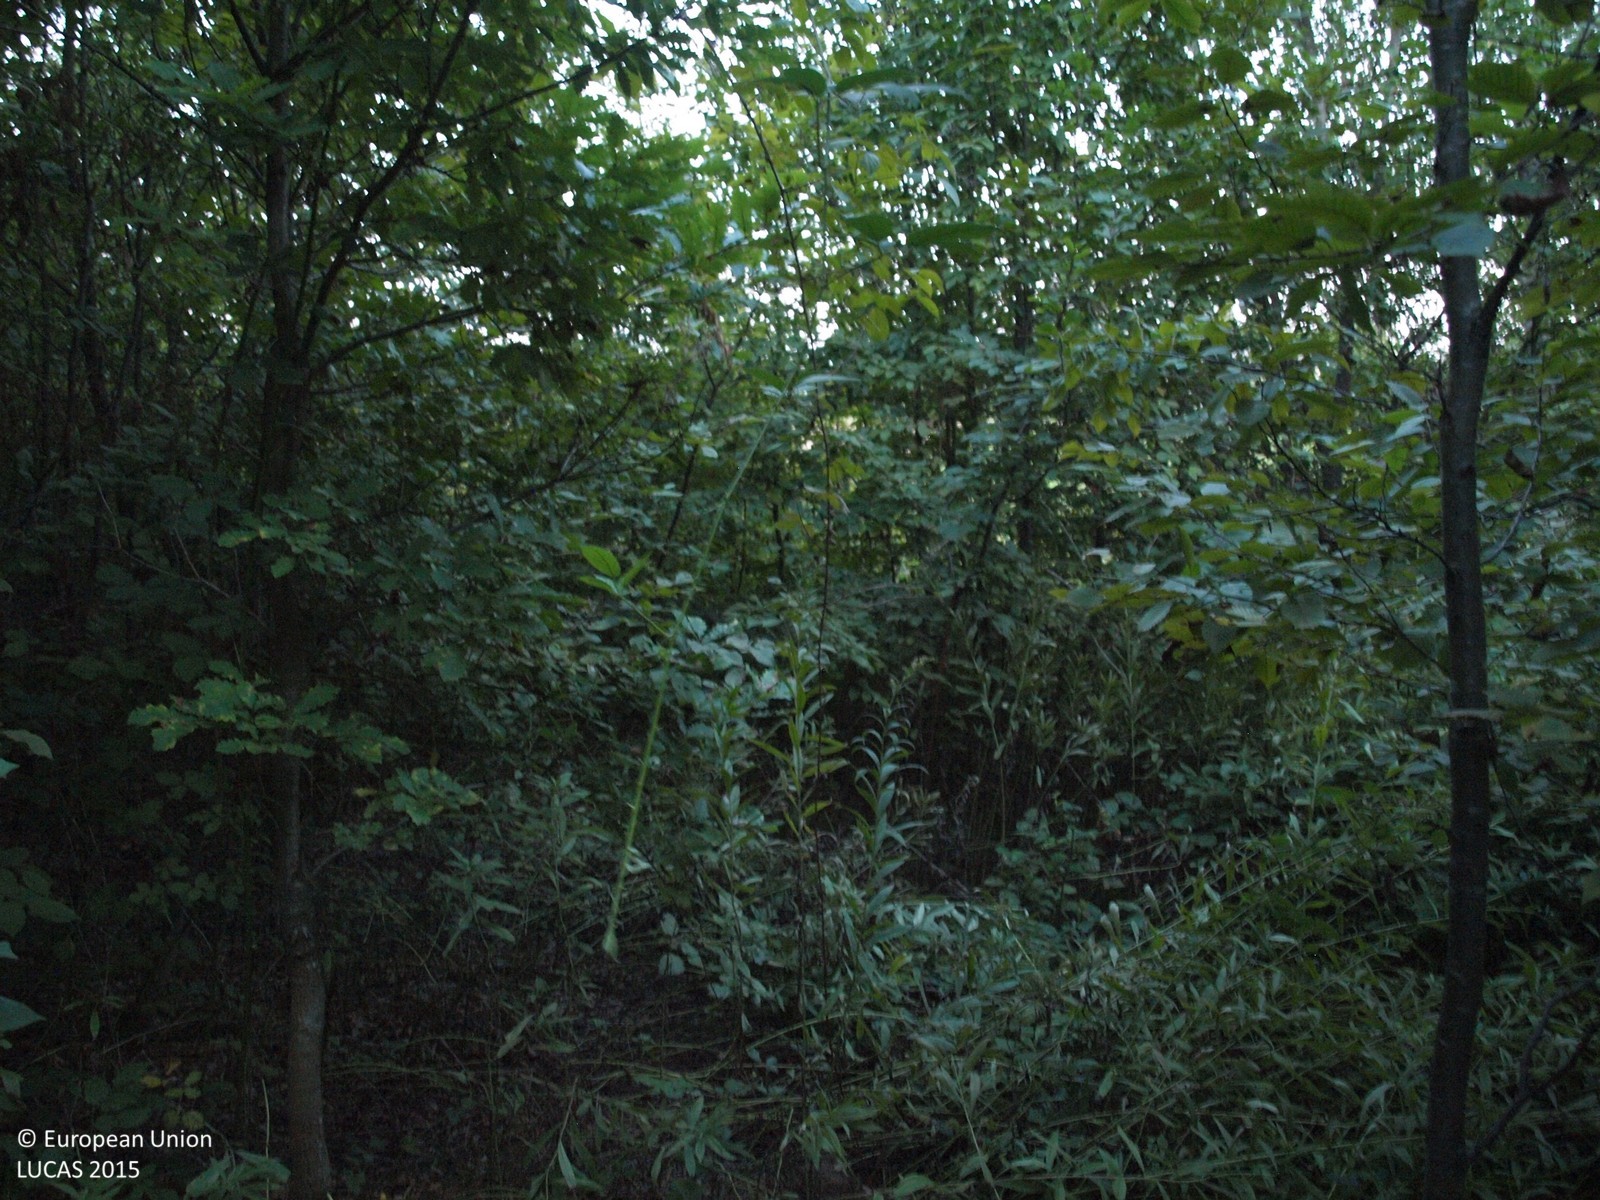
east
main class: Woodland
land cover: Broadleaved woodland
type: mesophytic deciduous forest
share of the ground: > 75 %
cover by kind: broadleaved forest trees 100 %
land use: Forestry
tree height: > 5 m
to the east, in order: Broadleaved woodland; Barley; Electric lines; Grass margins; Paved roads, cycling and walking lanes; Grass margins; Shrubland with sparse tree cover
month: September
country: HR
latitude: 45.5653
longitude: 16.0576
